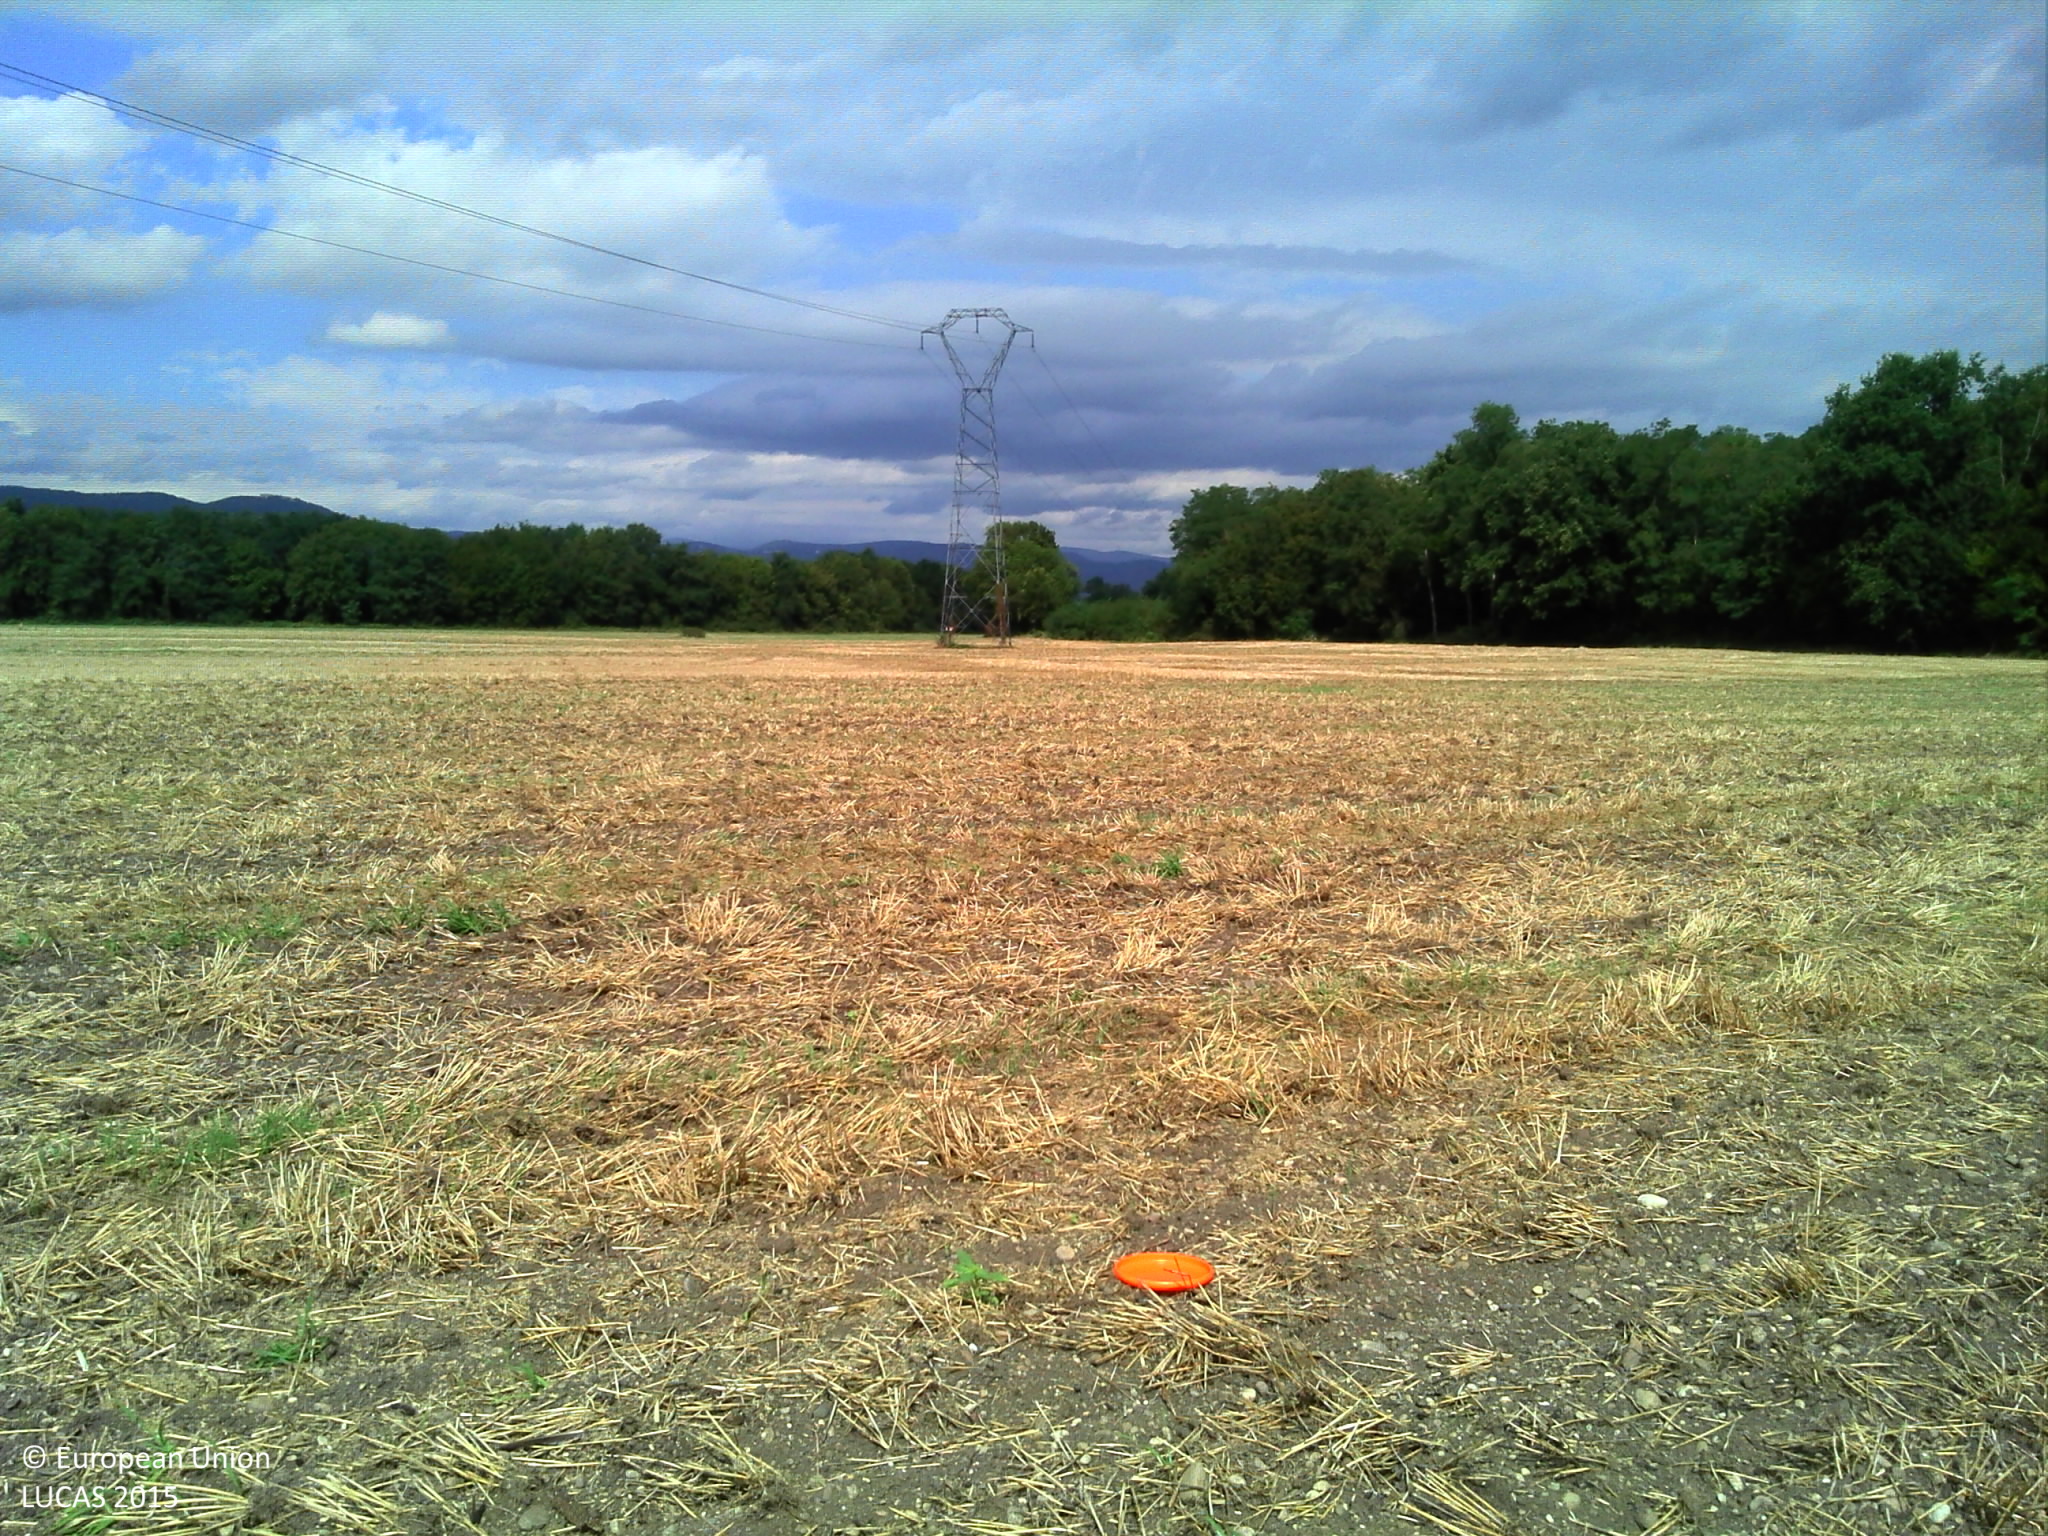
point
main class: Cropland
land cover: Common wheat
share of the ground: 10 - 25 %
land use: Agriculture (excluding fallow land and kitchen gardens)
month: August
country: FR
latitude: 48.0299
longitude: 7.3594
